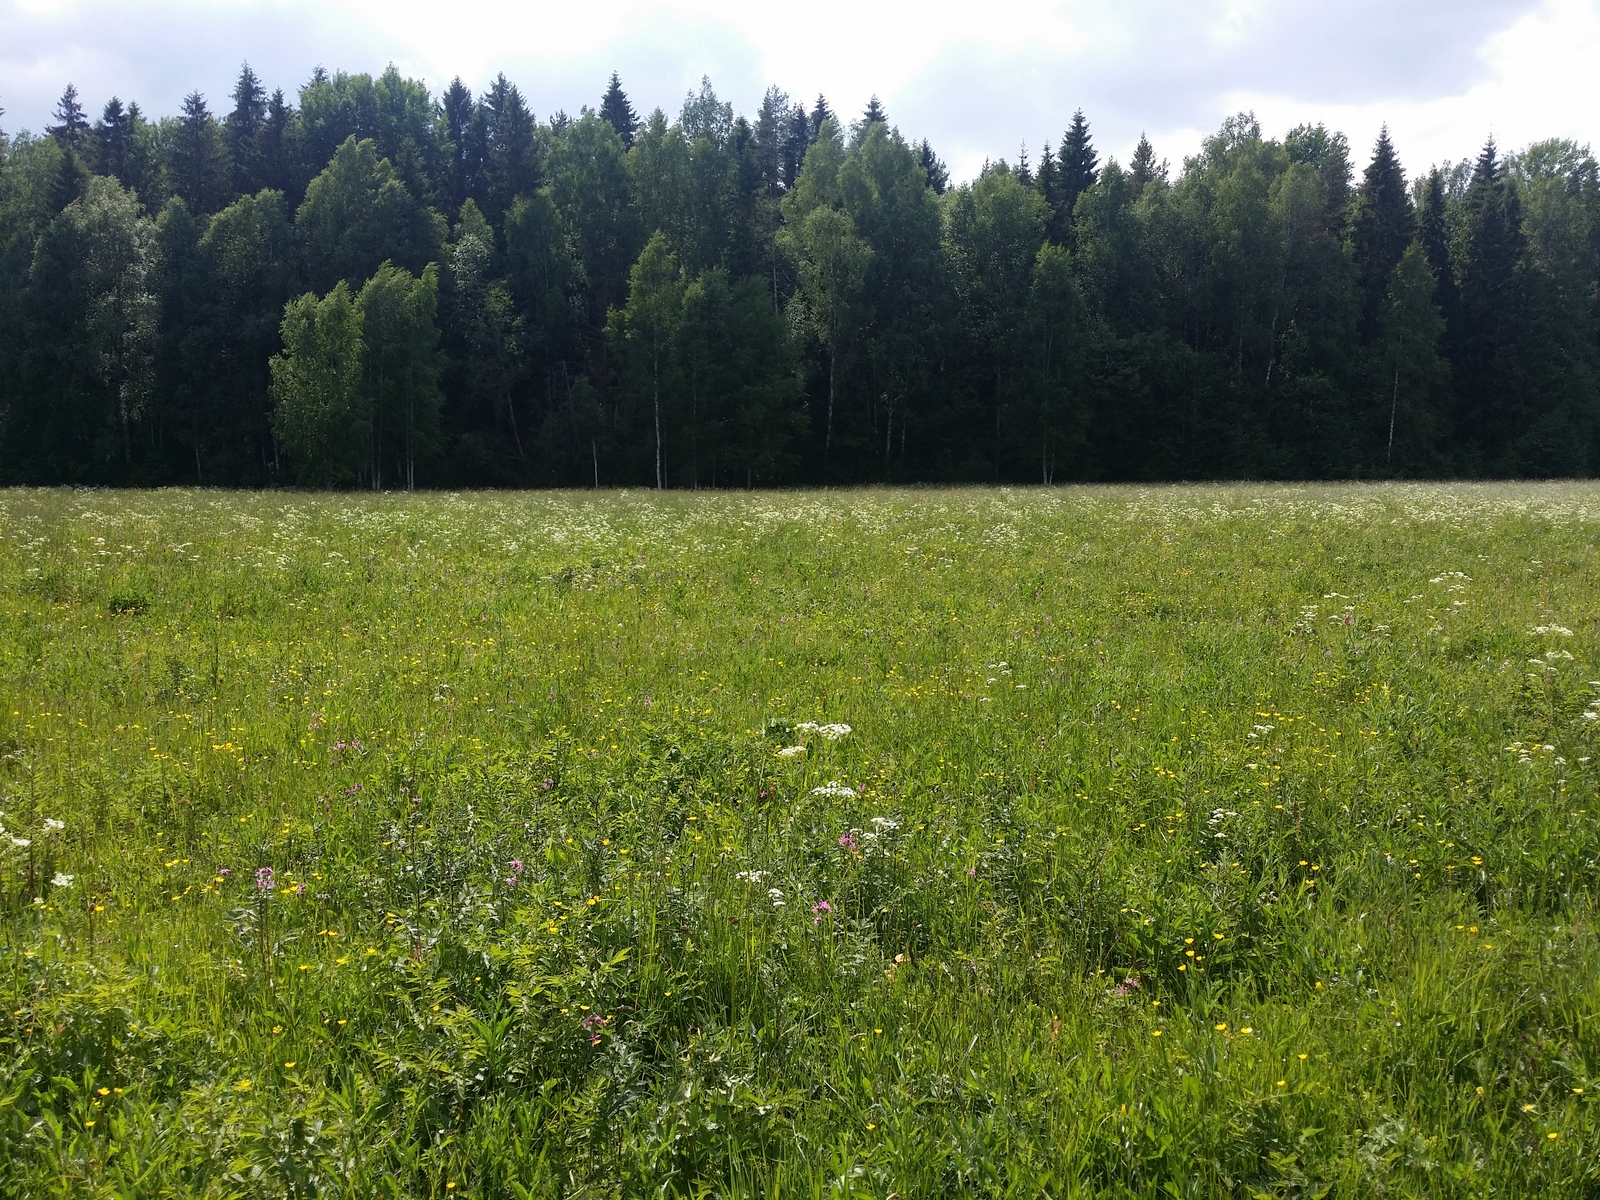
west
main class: Grassland
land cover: Spontaneously vegetated surfaces
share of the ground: > 75 %
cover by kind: herbaceous plants 100 %
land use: Fallow land
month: June
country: LV
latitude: 57.3740
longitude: 26.4902
